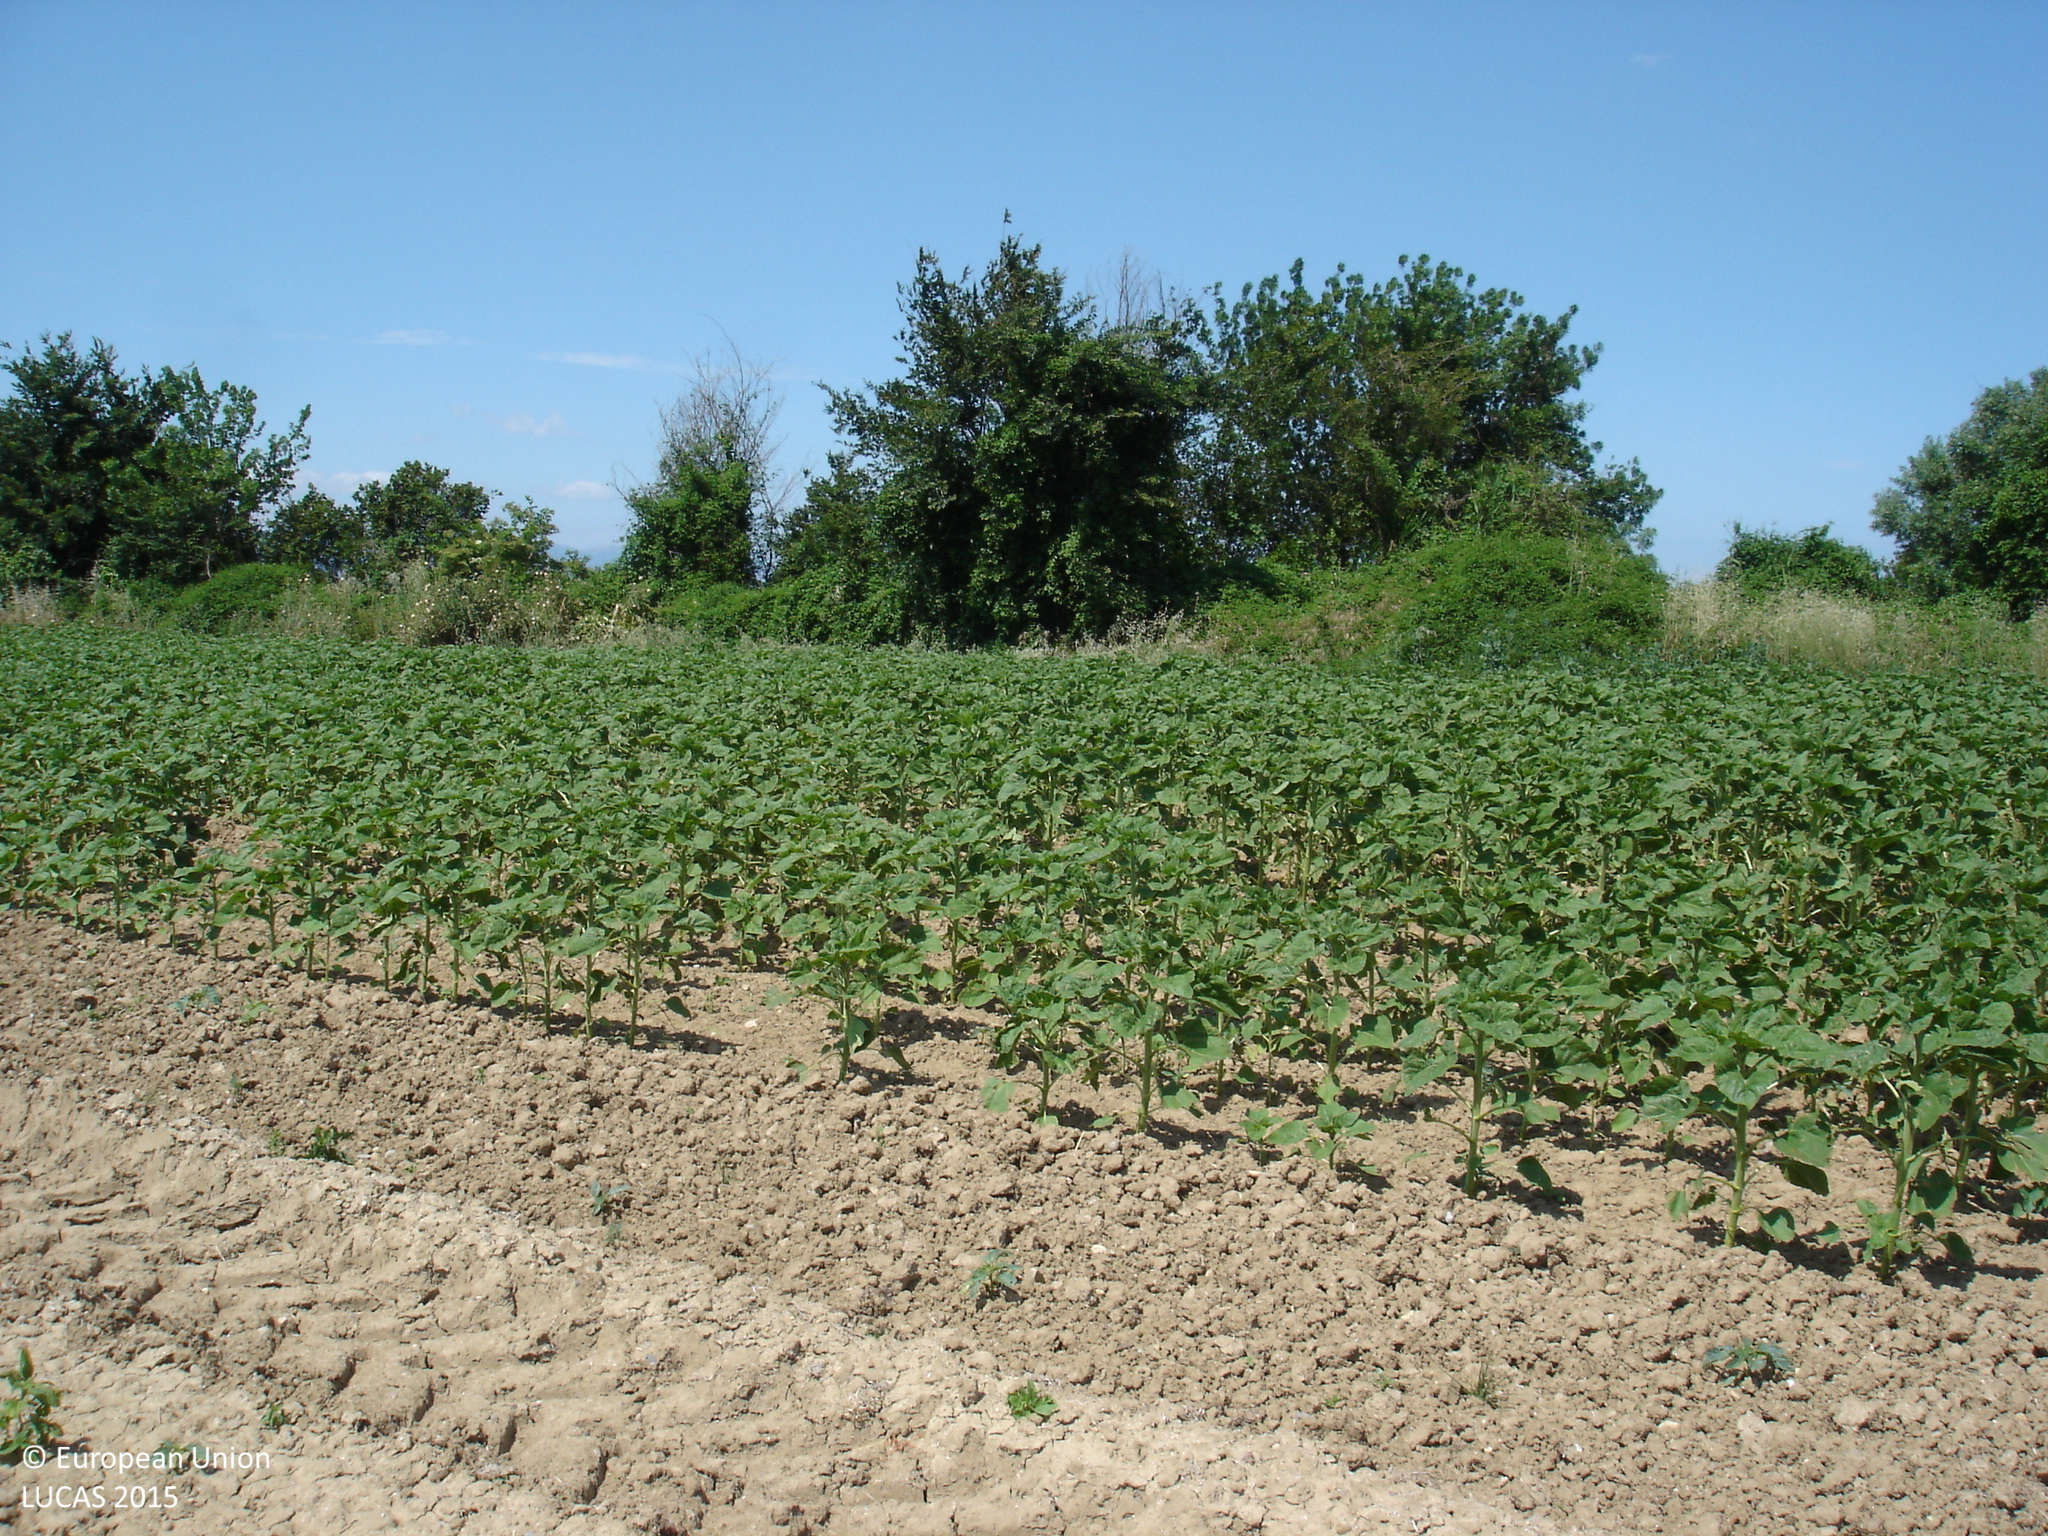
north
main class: Grassland
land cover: Grassland without tree/shrub cover
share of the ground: 10 - 25 %
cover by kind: consolidated bare surface 90 %, herbaceous plants 10 %
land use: Agriculture (excluding fallow land and kitchen gardens)
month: May
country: ES
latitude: 42.2124
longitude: 3.0010
